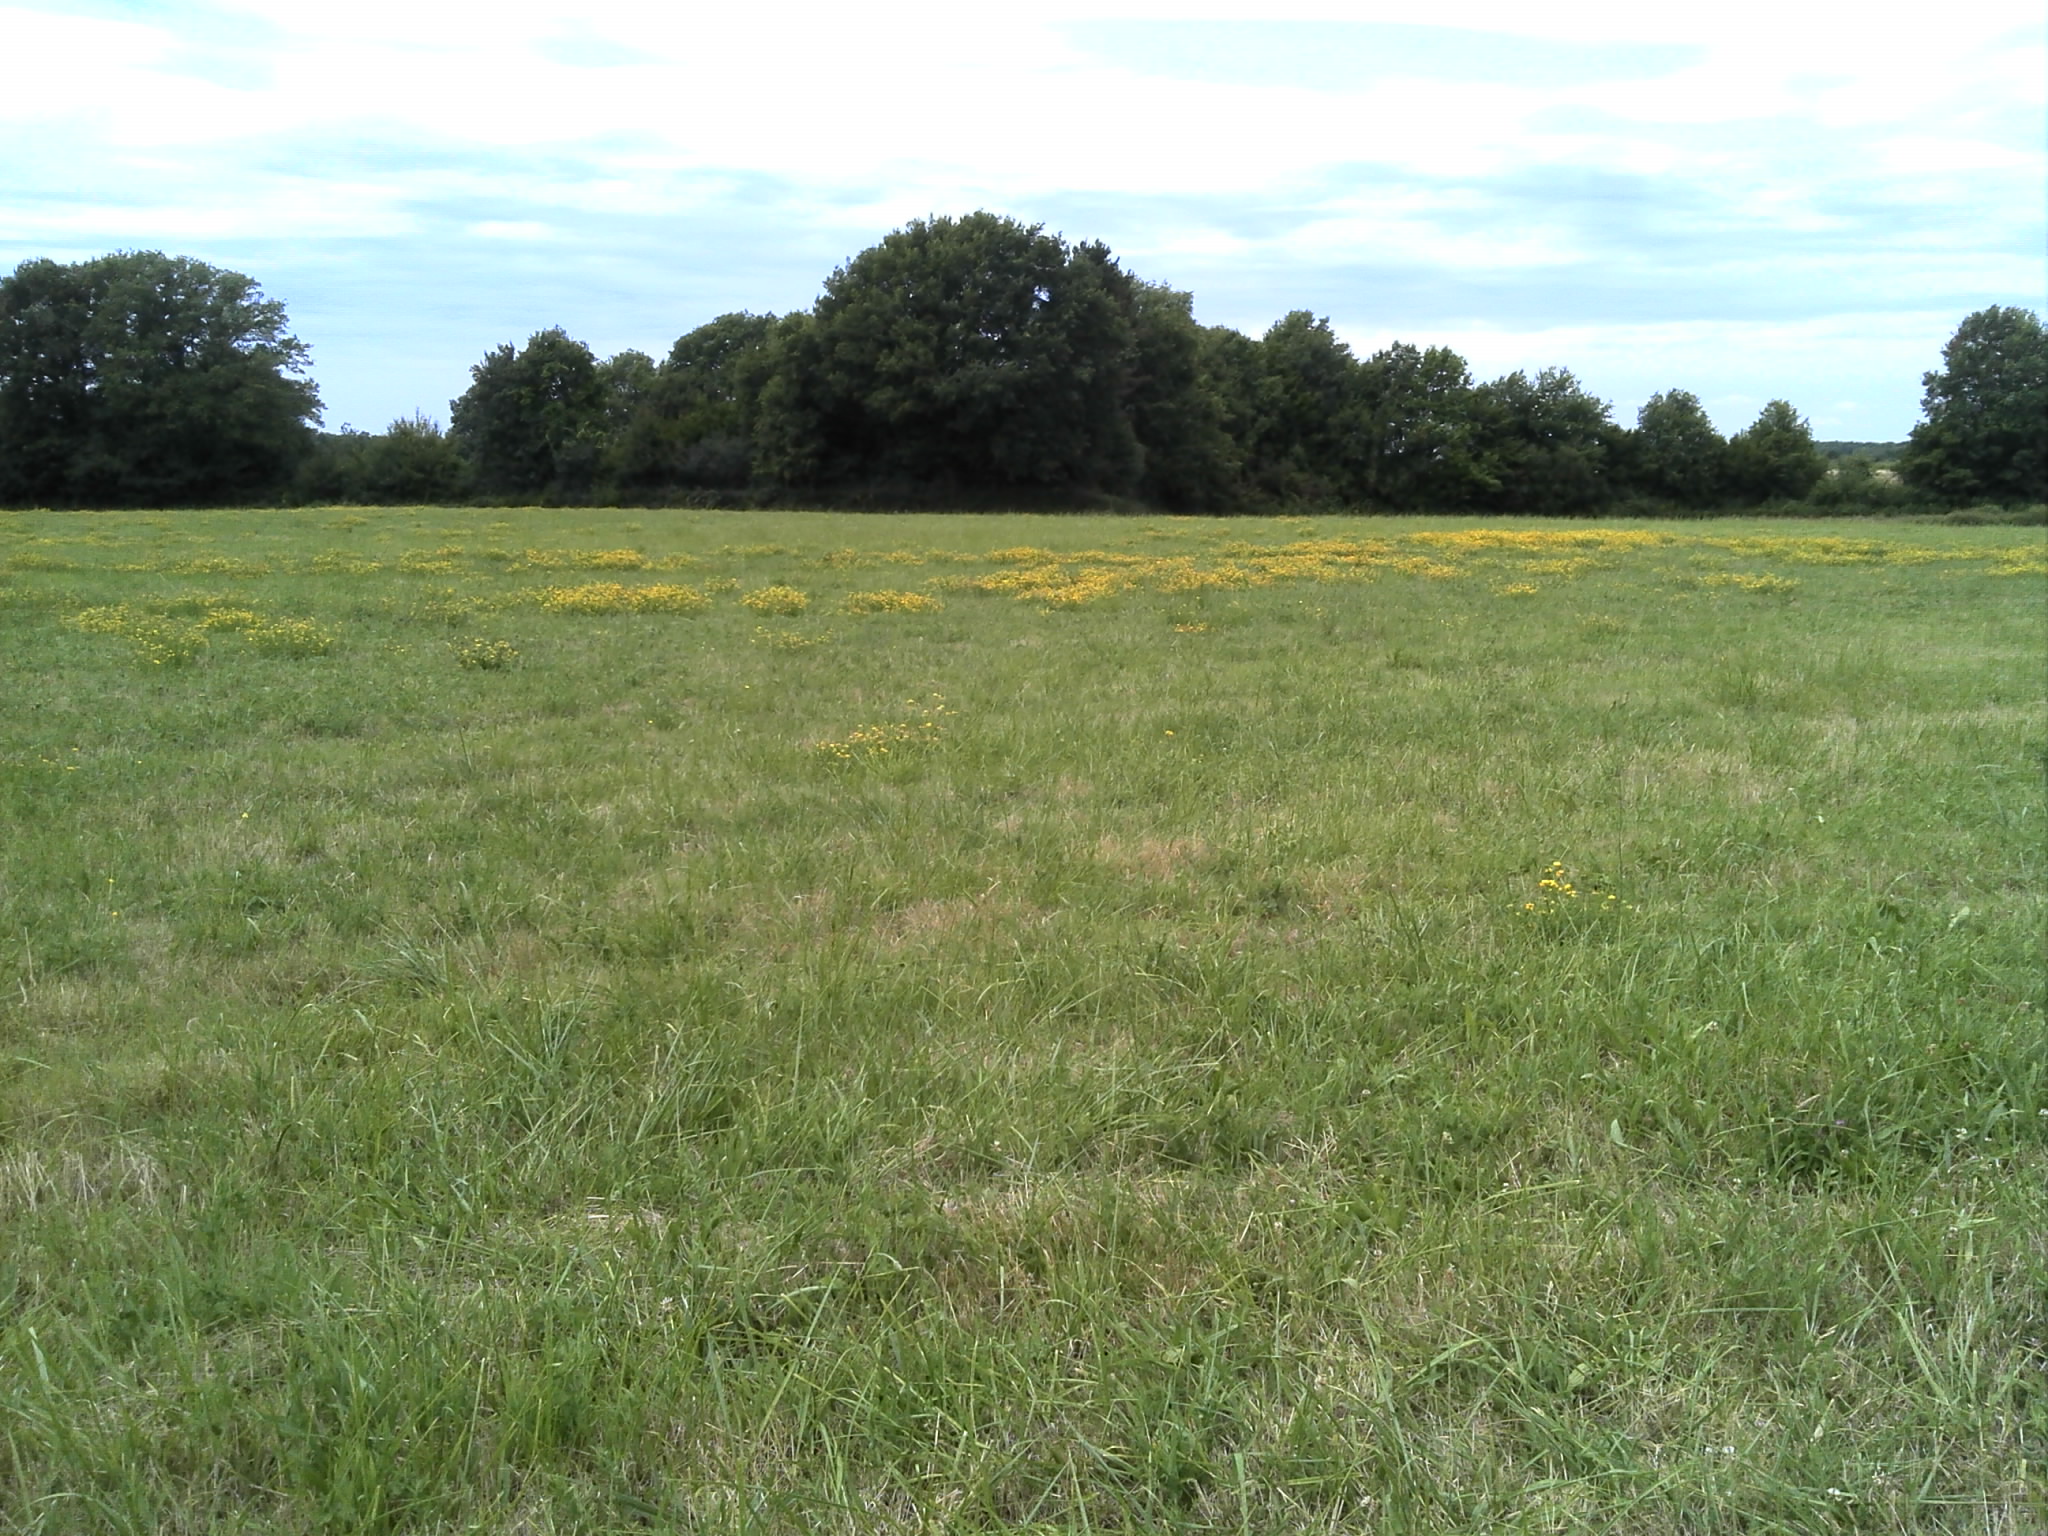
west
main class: Grassland
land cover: Grassland without tree/shrub cover
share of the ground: > 75 %
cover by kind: herbaceous plants 100 %
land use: Agriculture (excluding fallow land and kitchen gardens)
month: July
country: FR
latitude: 46.7184
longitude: 1.4982
